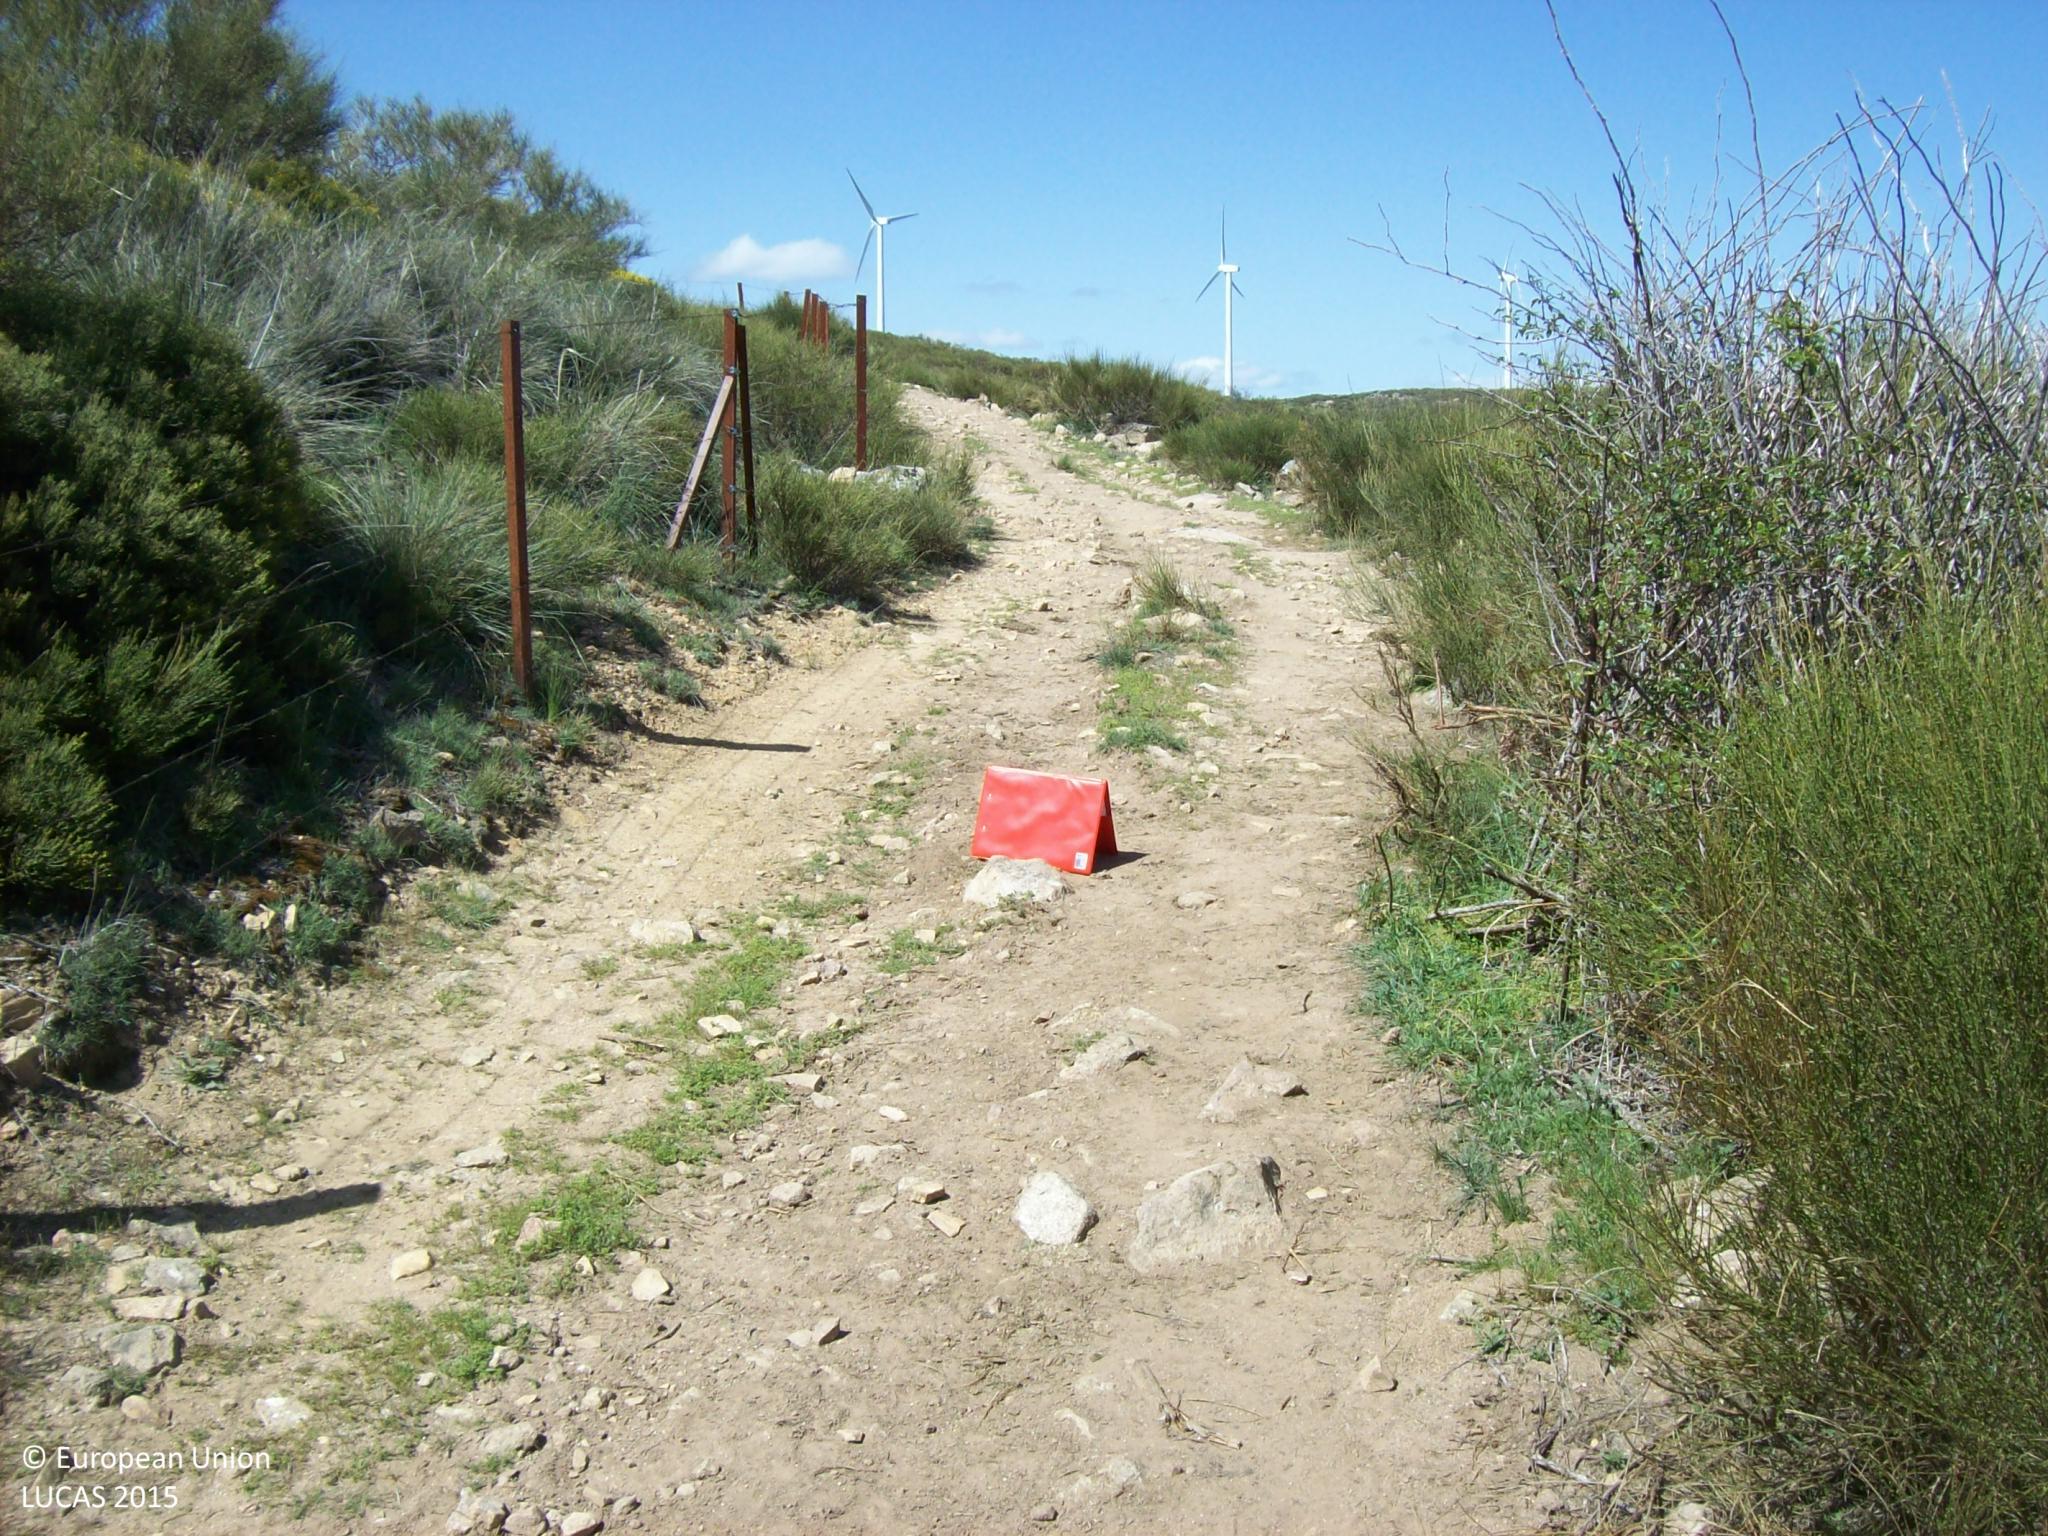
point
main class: Shrubland
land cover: Shrubland without tree cover
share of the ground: > 75 %
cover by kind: shrubs 95 %, herbaceous plants 5 %
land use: Agriculture (excluding fallow land and kitchen gardens)
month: May
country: ES
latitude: 40.6238
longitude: -4.4377
